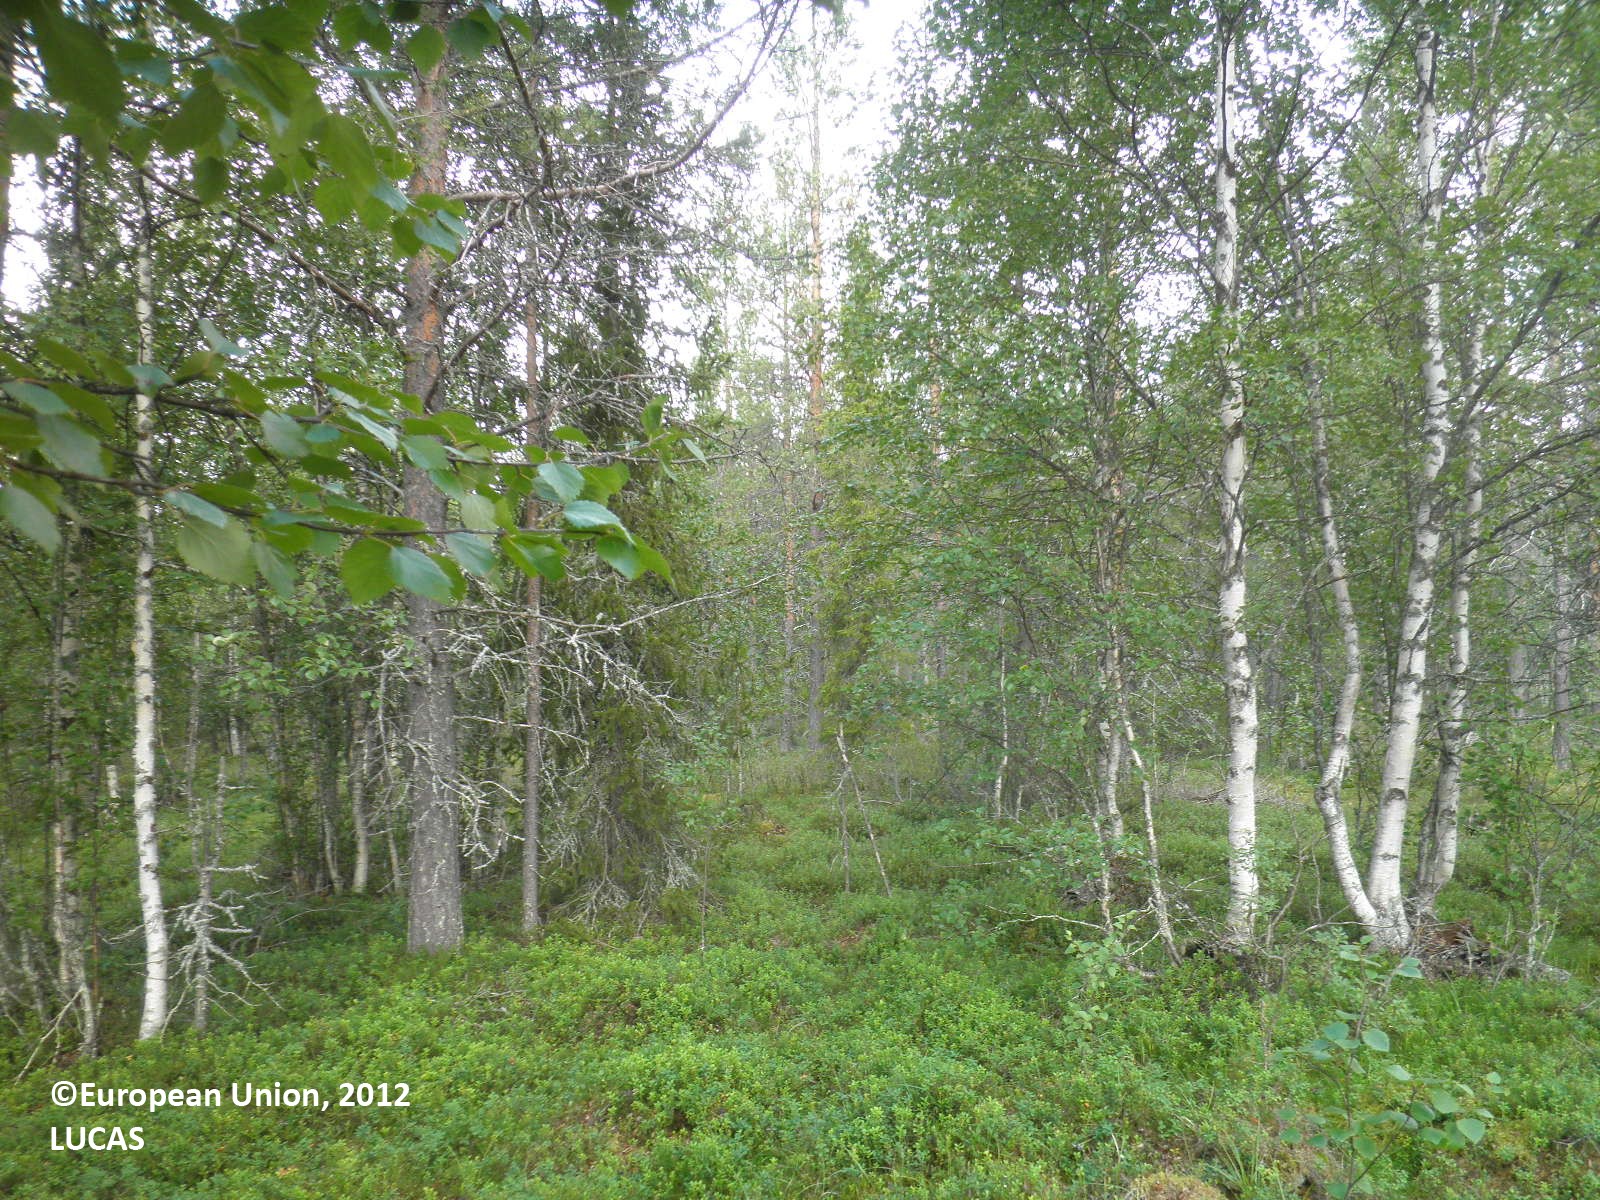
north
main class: Woodland
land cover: Pine dominated mixed woodland
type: boreal forest
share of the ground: 25 - 50 %
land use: Forestry
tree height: > 5 m
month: August
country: FI
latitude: 67.3968
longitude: 27.7566
